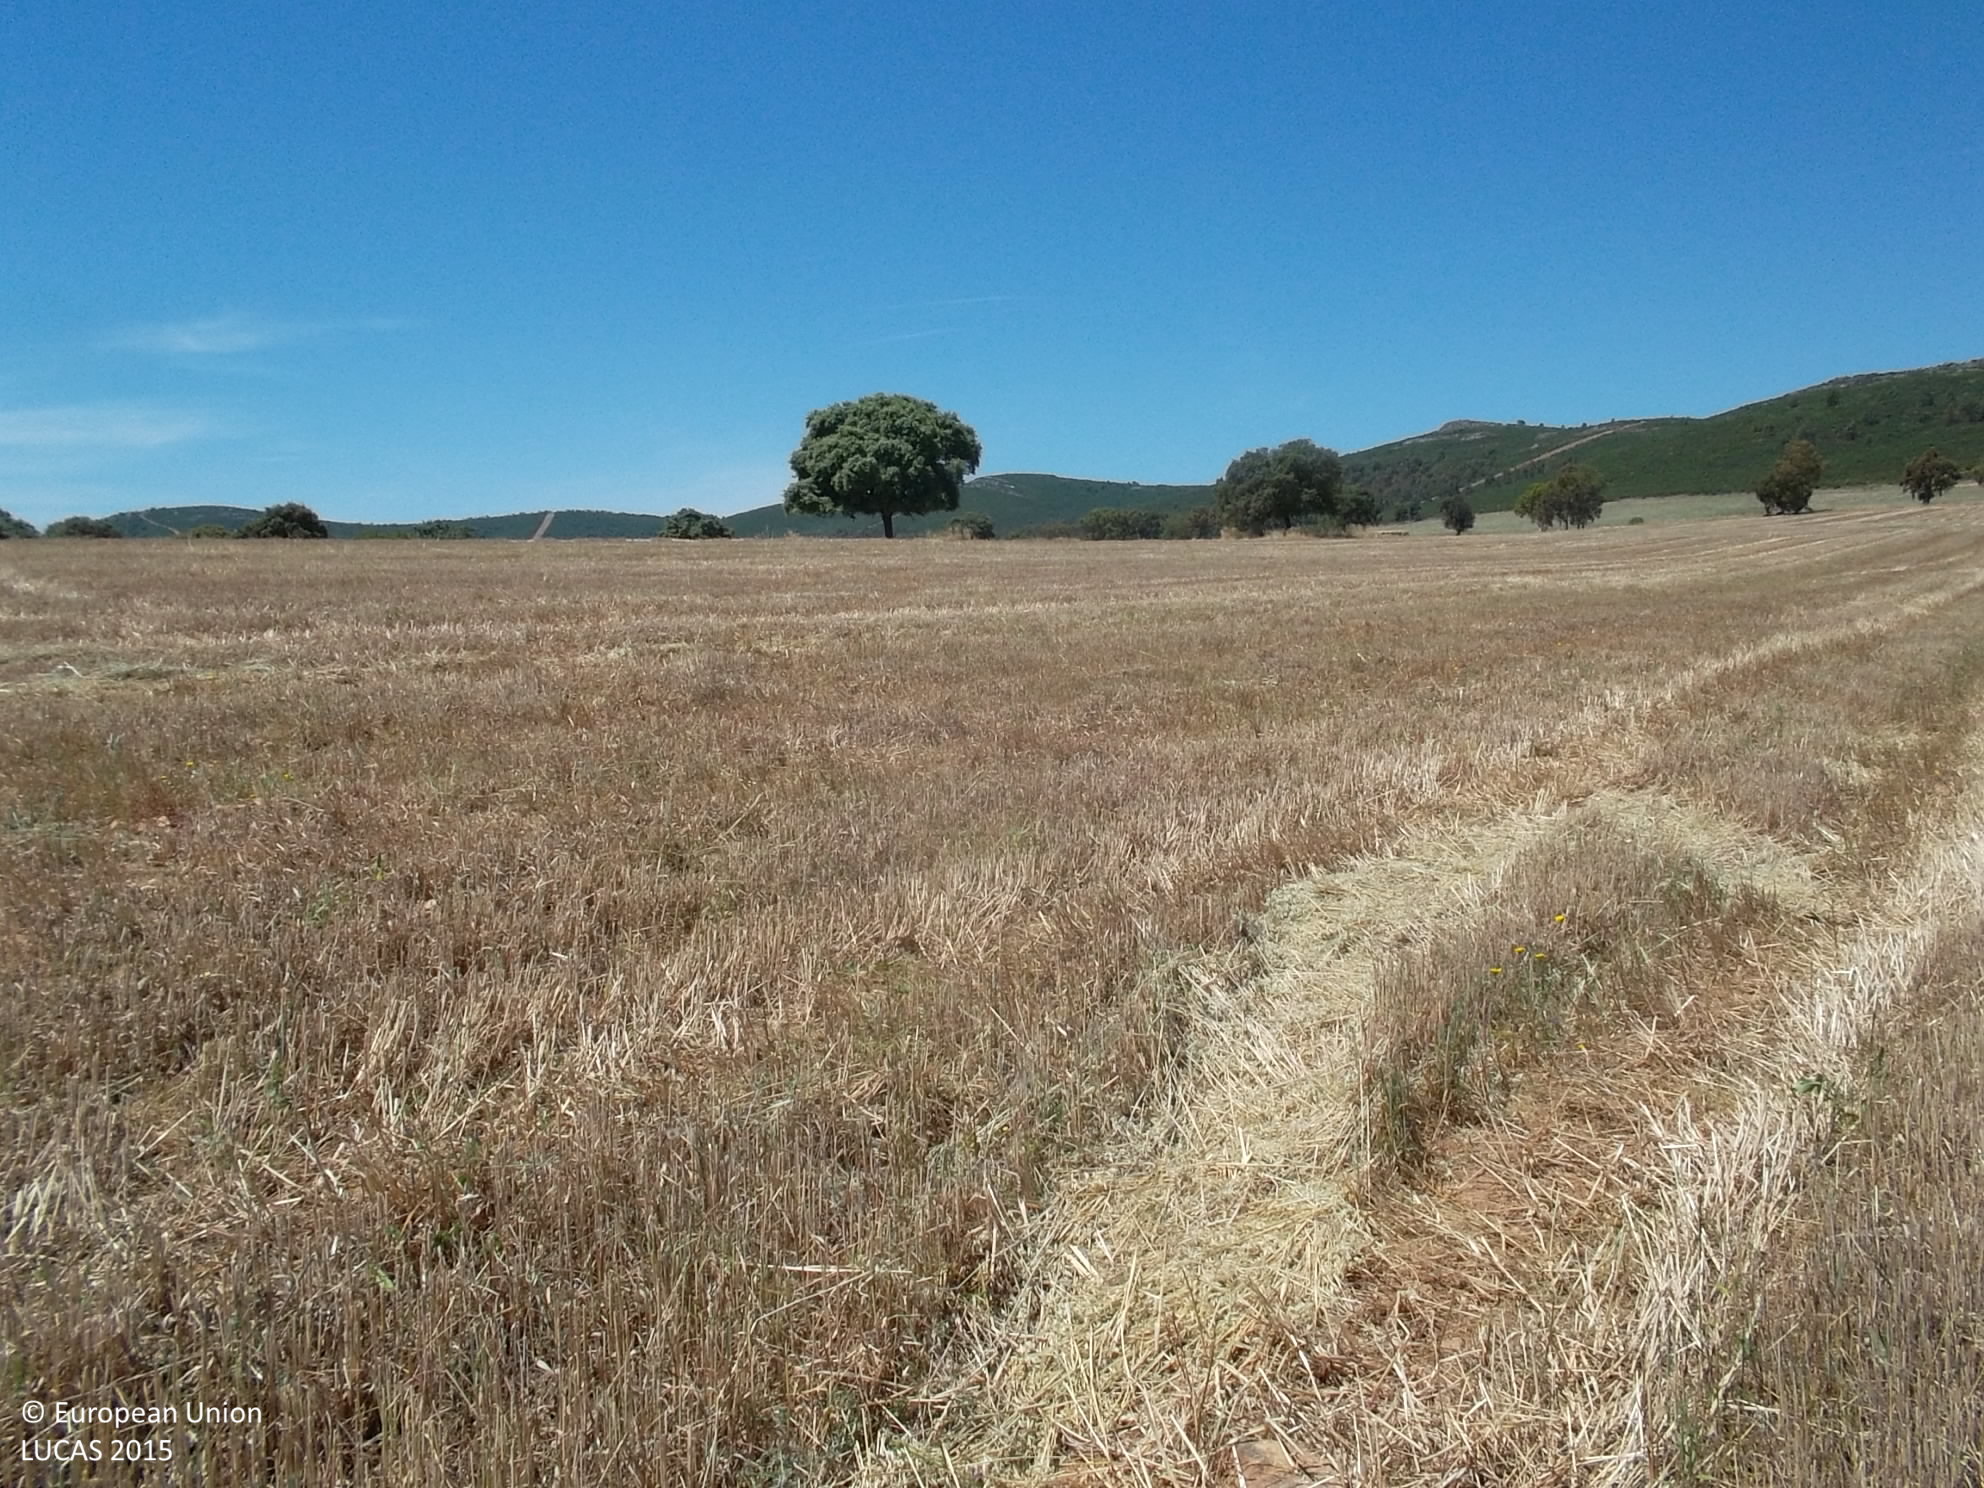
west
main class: Cropland
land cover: Oats
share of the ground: > 75 %
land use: Agriculture (excluding fallow land and kitchen gardens)
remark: Harvested field
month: May
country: ES
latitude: 38.9229
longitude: -4.5259
